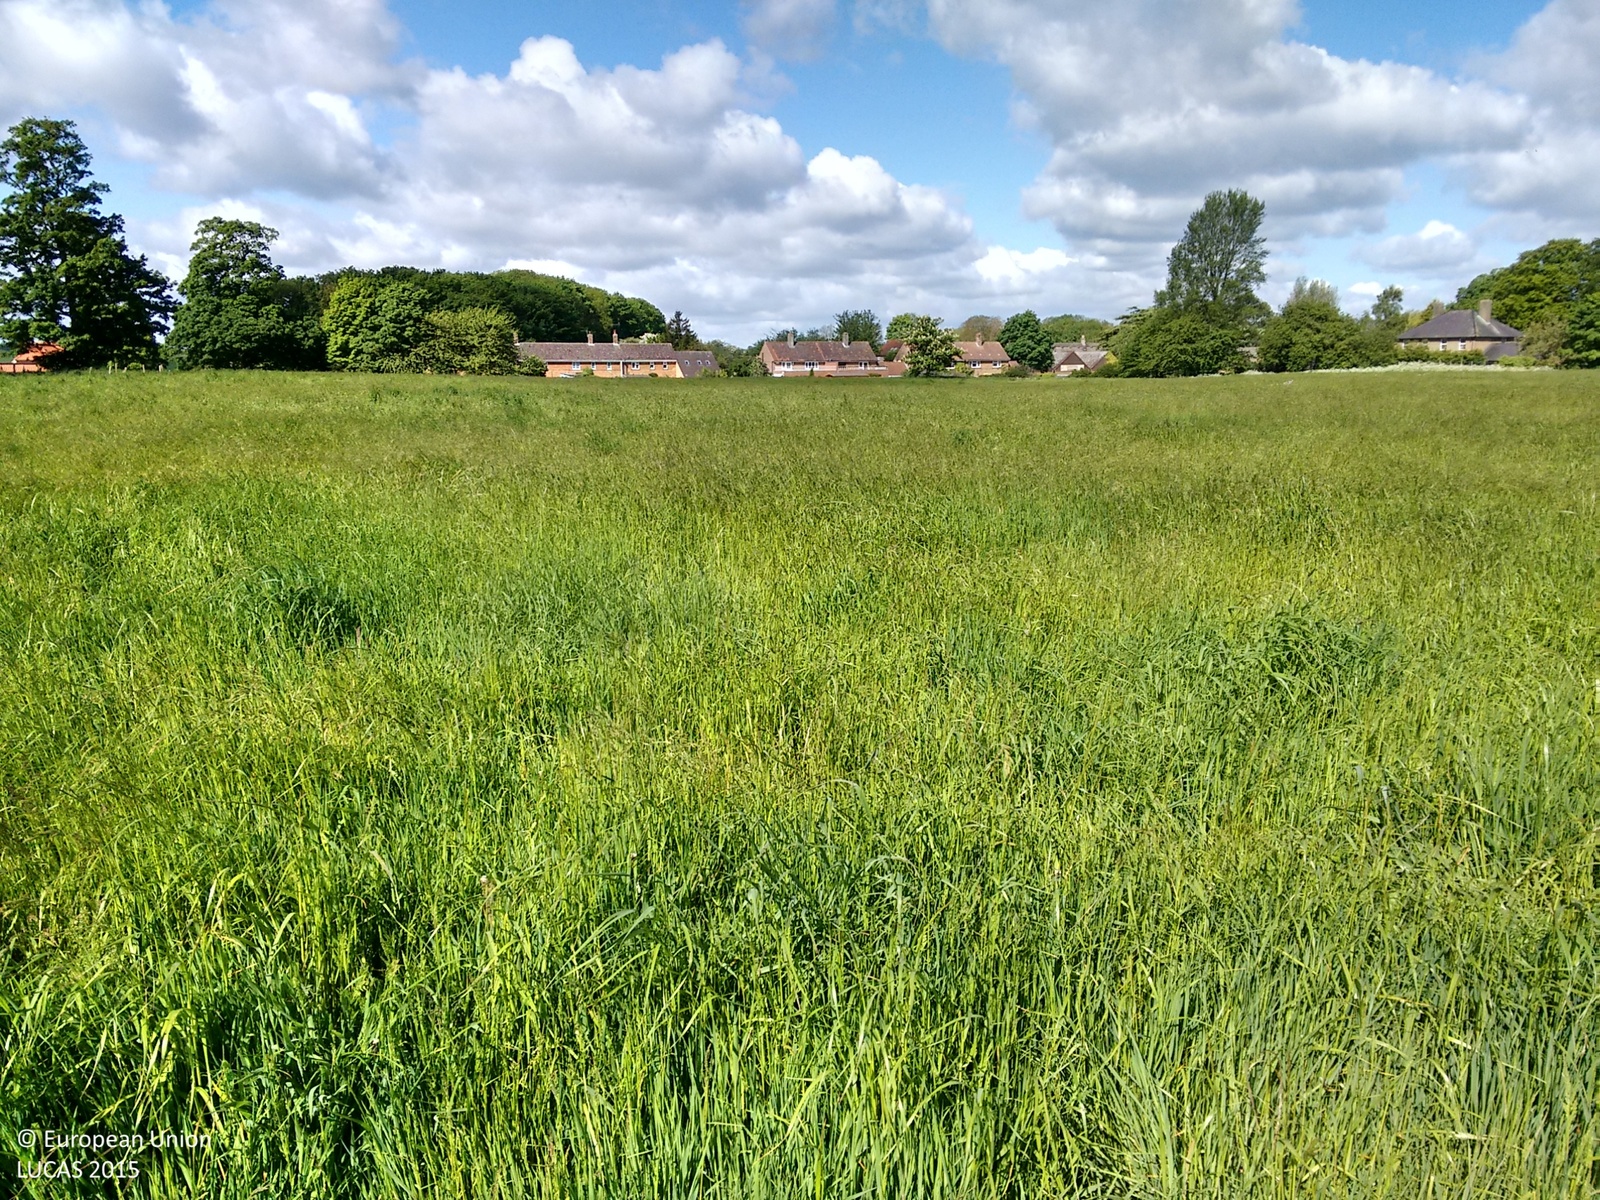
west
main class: Grassland
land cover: Grassland without tree/shrub cover
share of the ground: > 75 %
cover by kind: herbaceous plants 100 %
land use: Agriculture (excluding fallow land and kitchen gardens)
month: May
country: GB
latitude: 53.5611
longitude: -0.2857
